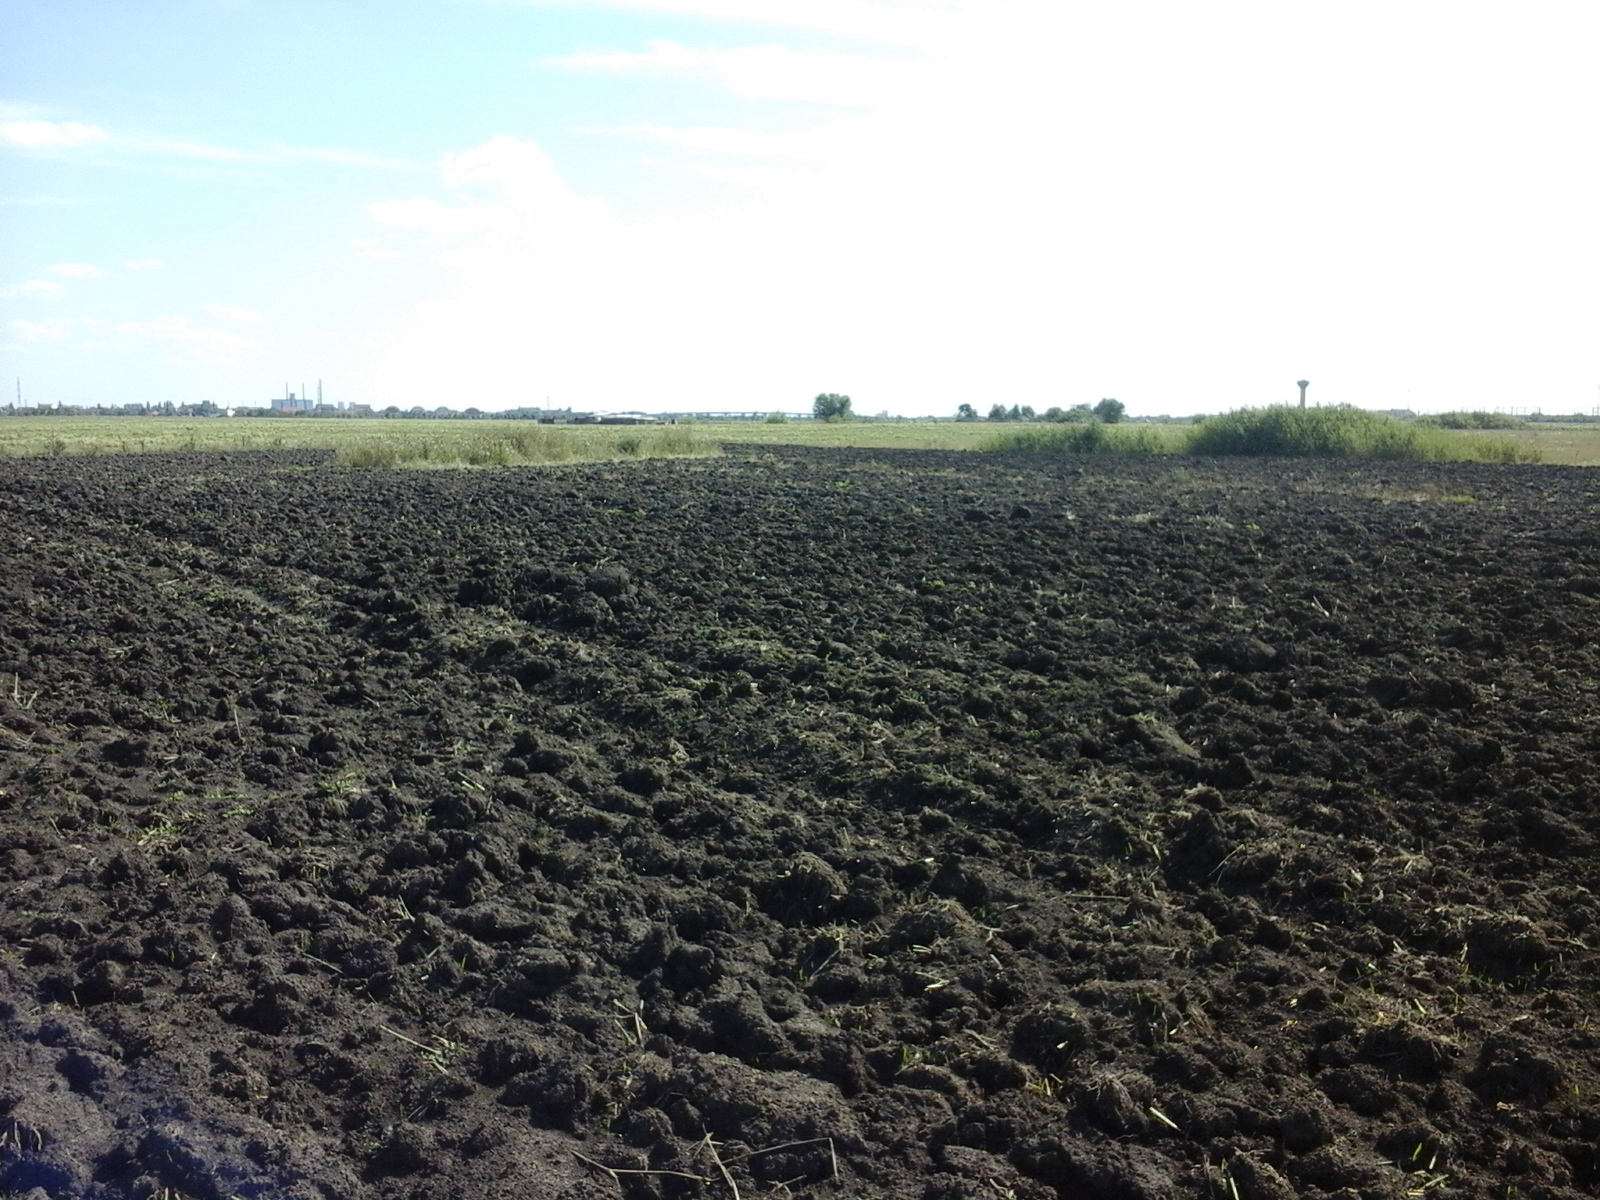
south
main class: Cropland
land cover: Oats
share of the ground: < 10 %
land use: Agriculture (excluding fallow land and kitchen gardens)
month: August
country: RO
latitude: 45.7812
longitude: 21.1814
